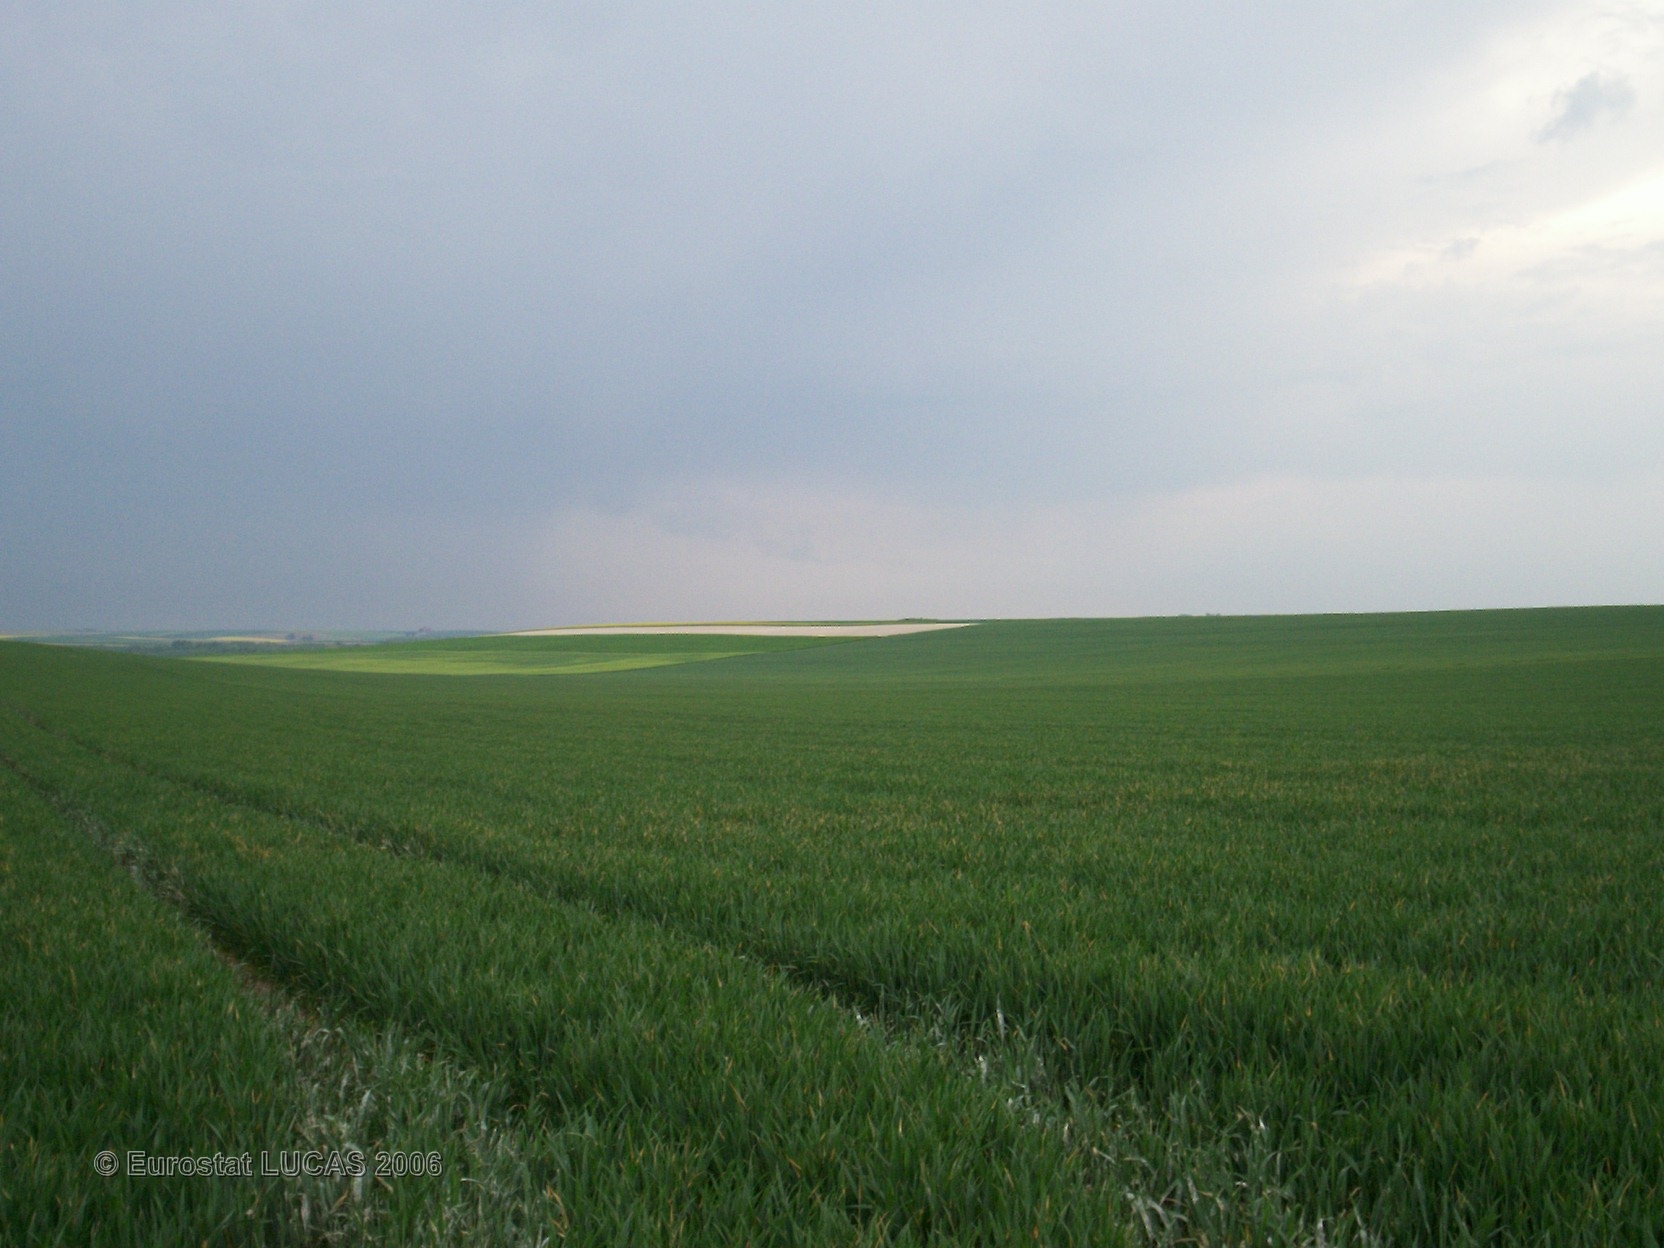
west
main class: Cropland
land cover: Common wheat
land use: Agriculture (excluding fallow land and kitchen gardens)
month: May
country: FR
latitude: 49.5377
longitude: 4.3162
